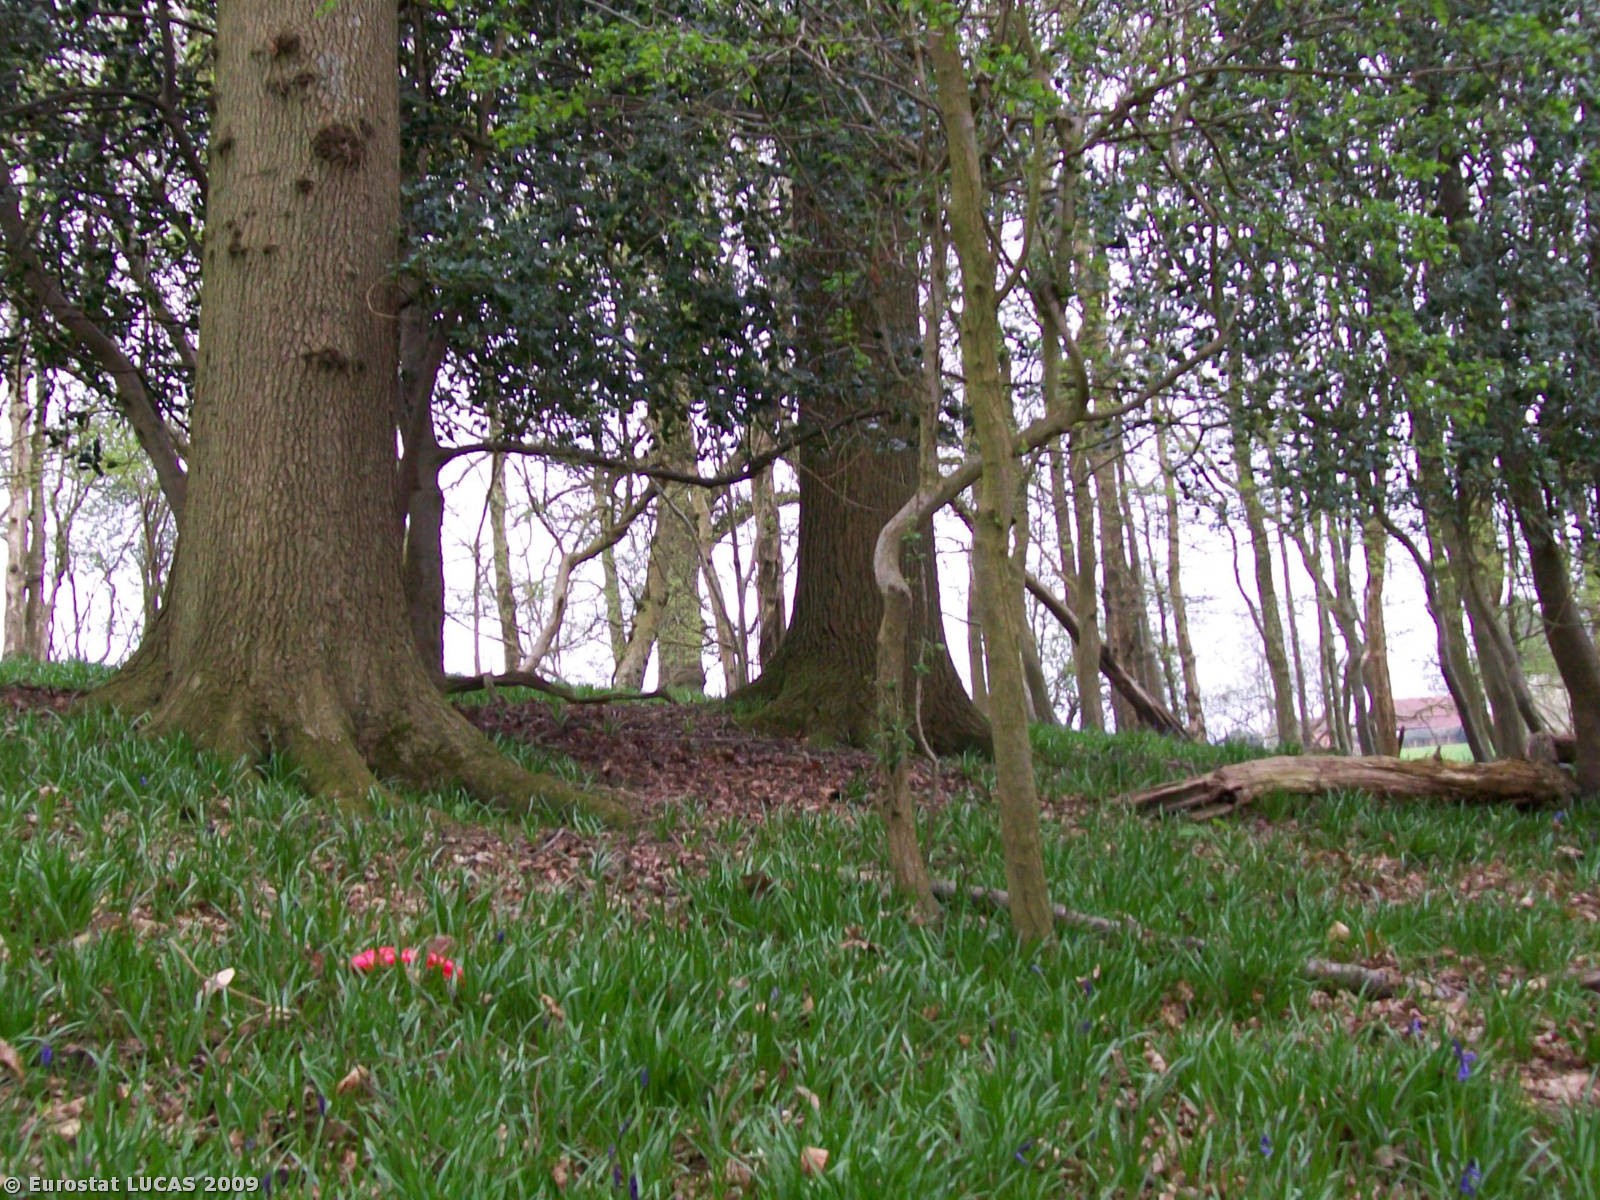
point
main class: Woodland
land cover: Mixed woodland
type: mesophytic deciduous forest
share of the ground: > 75 %
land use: Forestry
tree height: > 5 m
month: April
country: GB
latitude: 50.9523
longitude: 0.3622
